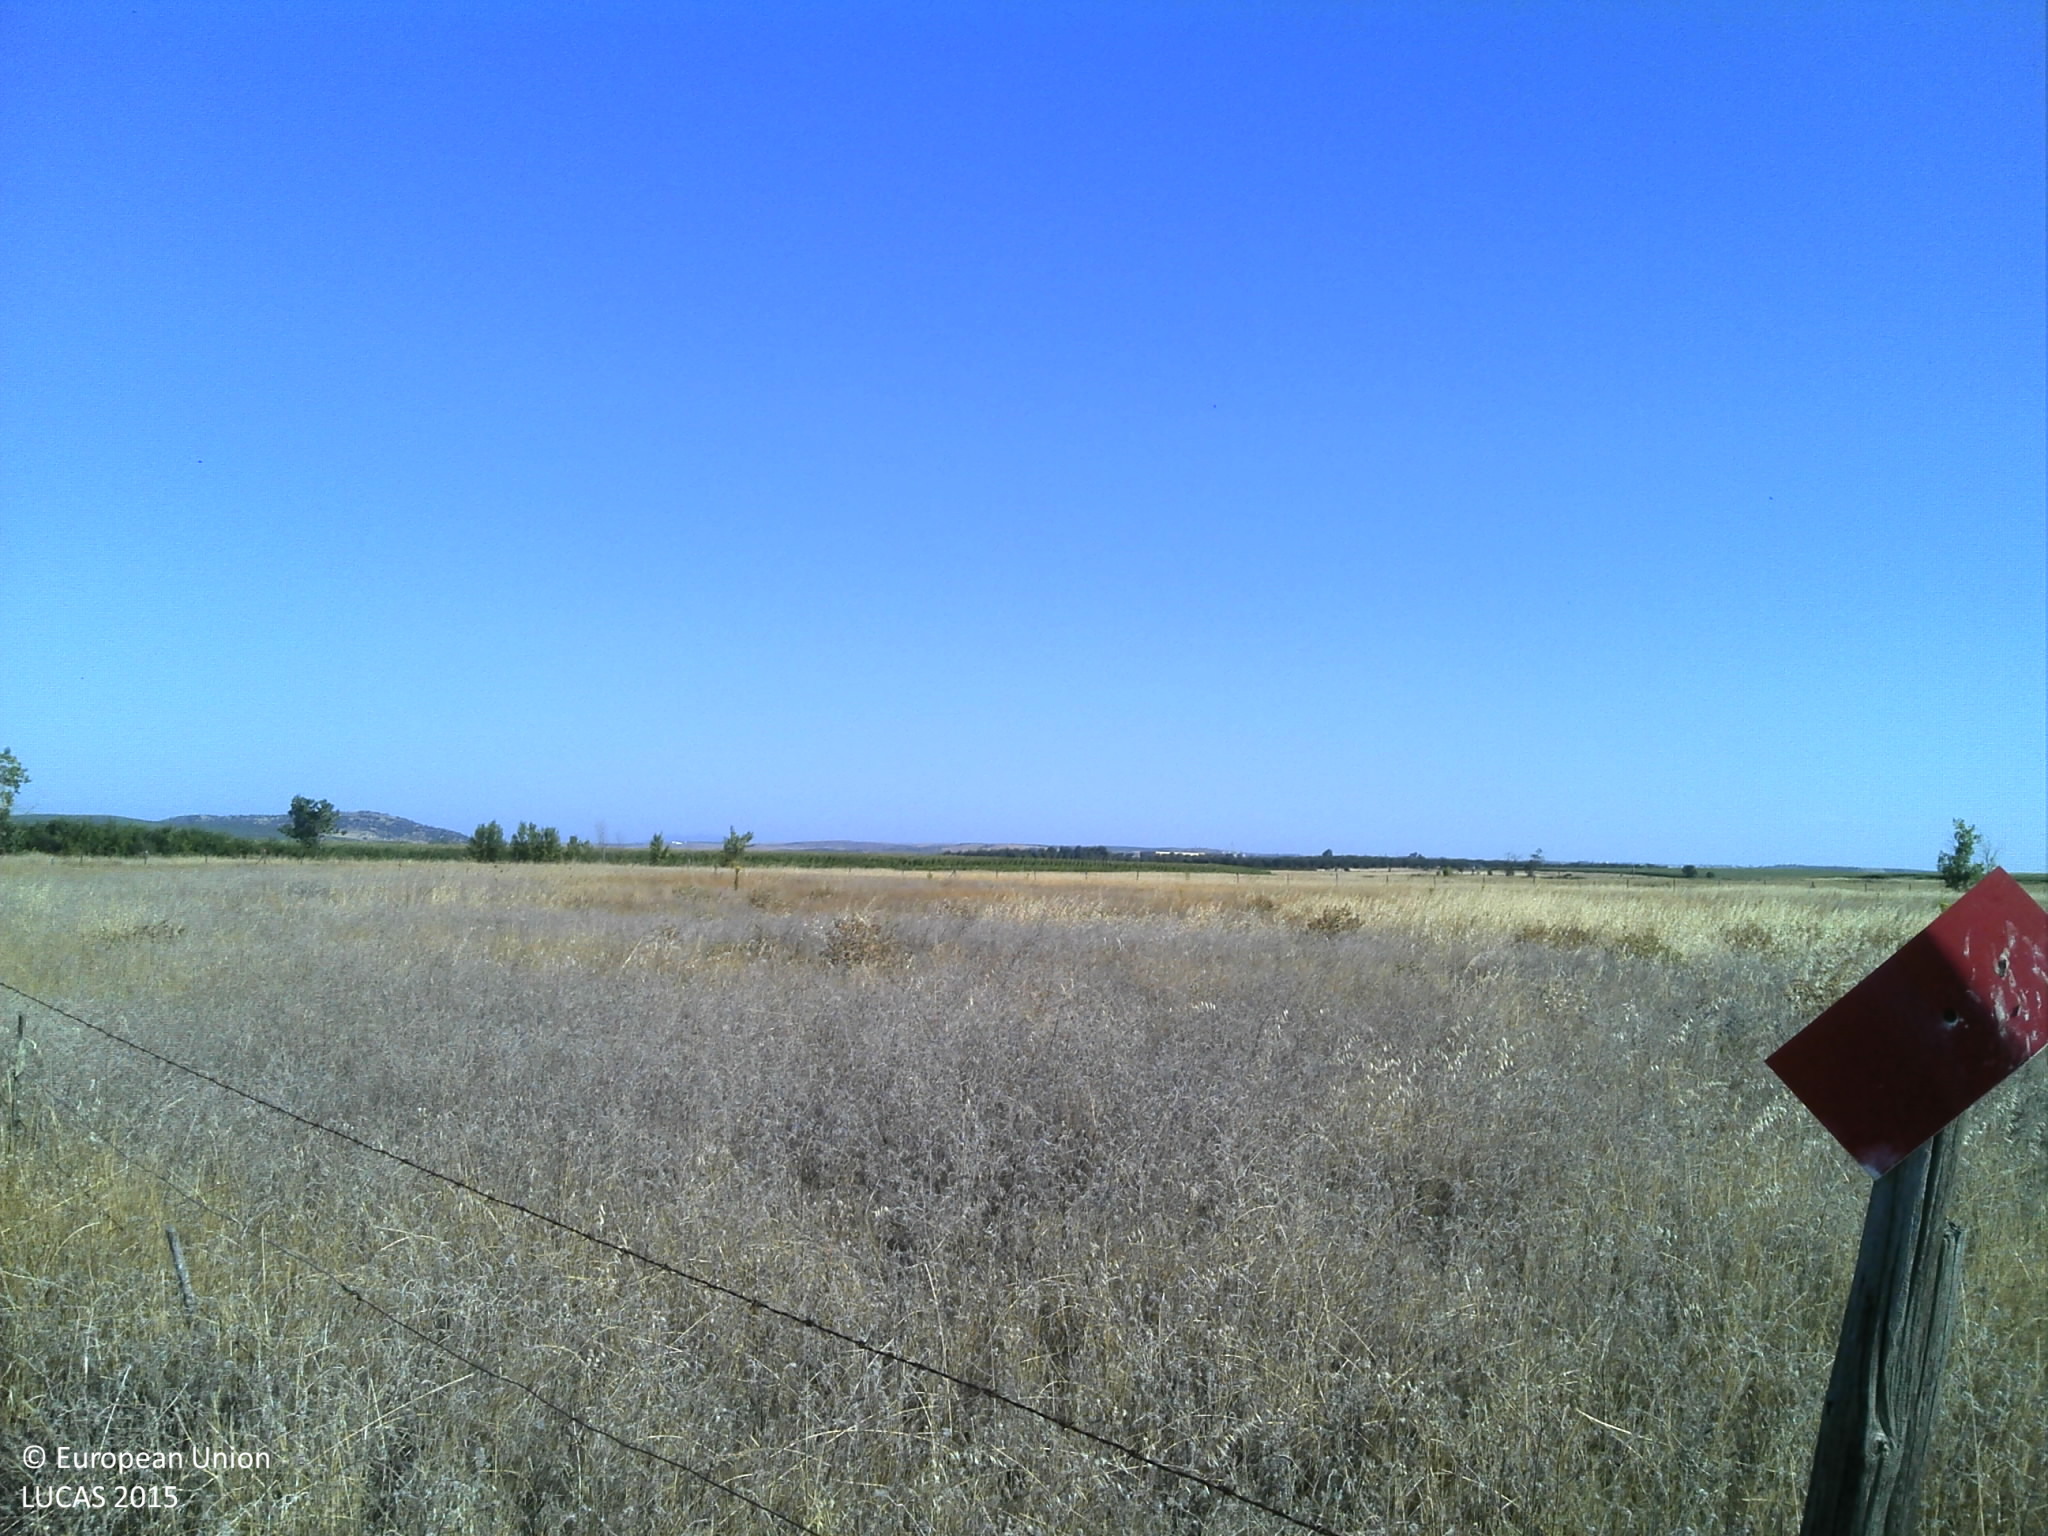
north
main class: Grassland
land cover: Grassland without tree/shrub cover
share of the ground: 50 - 75 %
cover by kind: herbaceous plants 75 %, unconsolidated bare surface 25 %
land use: Agriculture (excluding fallow land and kitchen gardens)
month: July
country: PT
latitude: 38.9261
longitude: -7.0633
